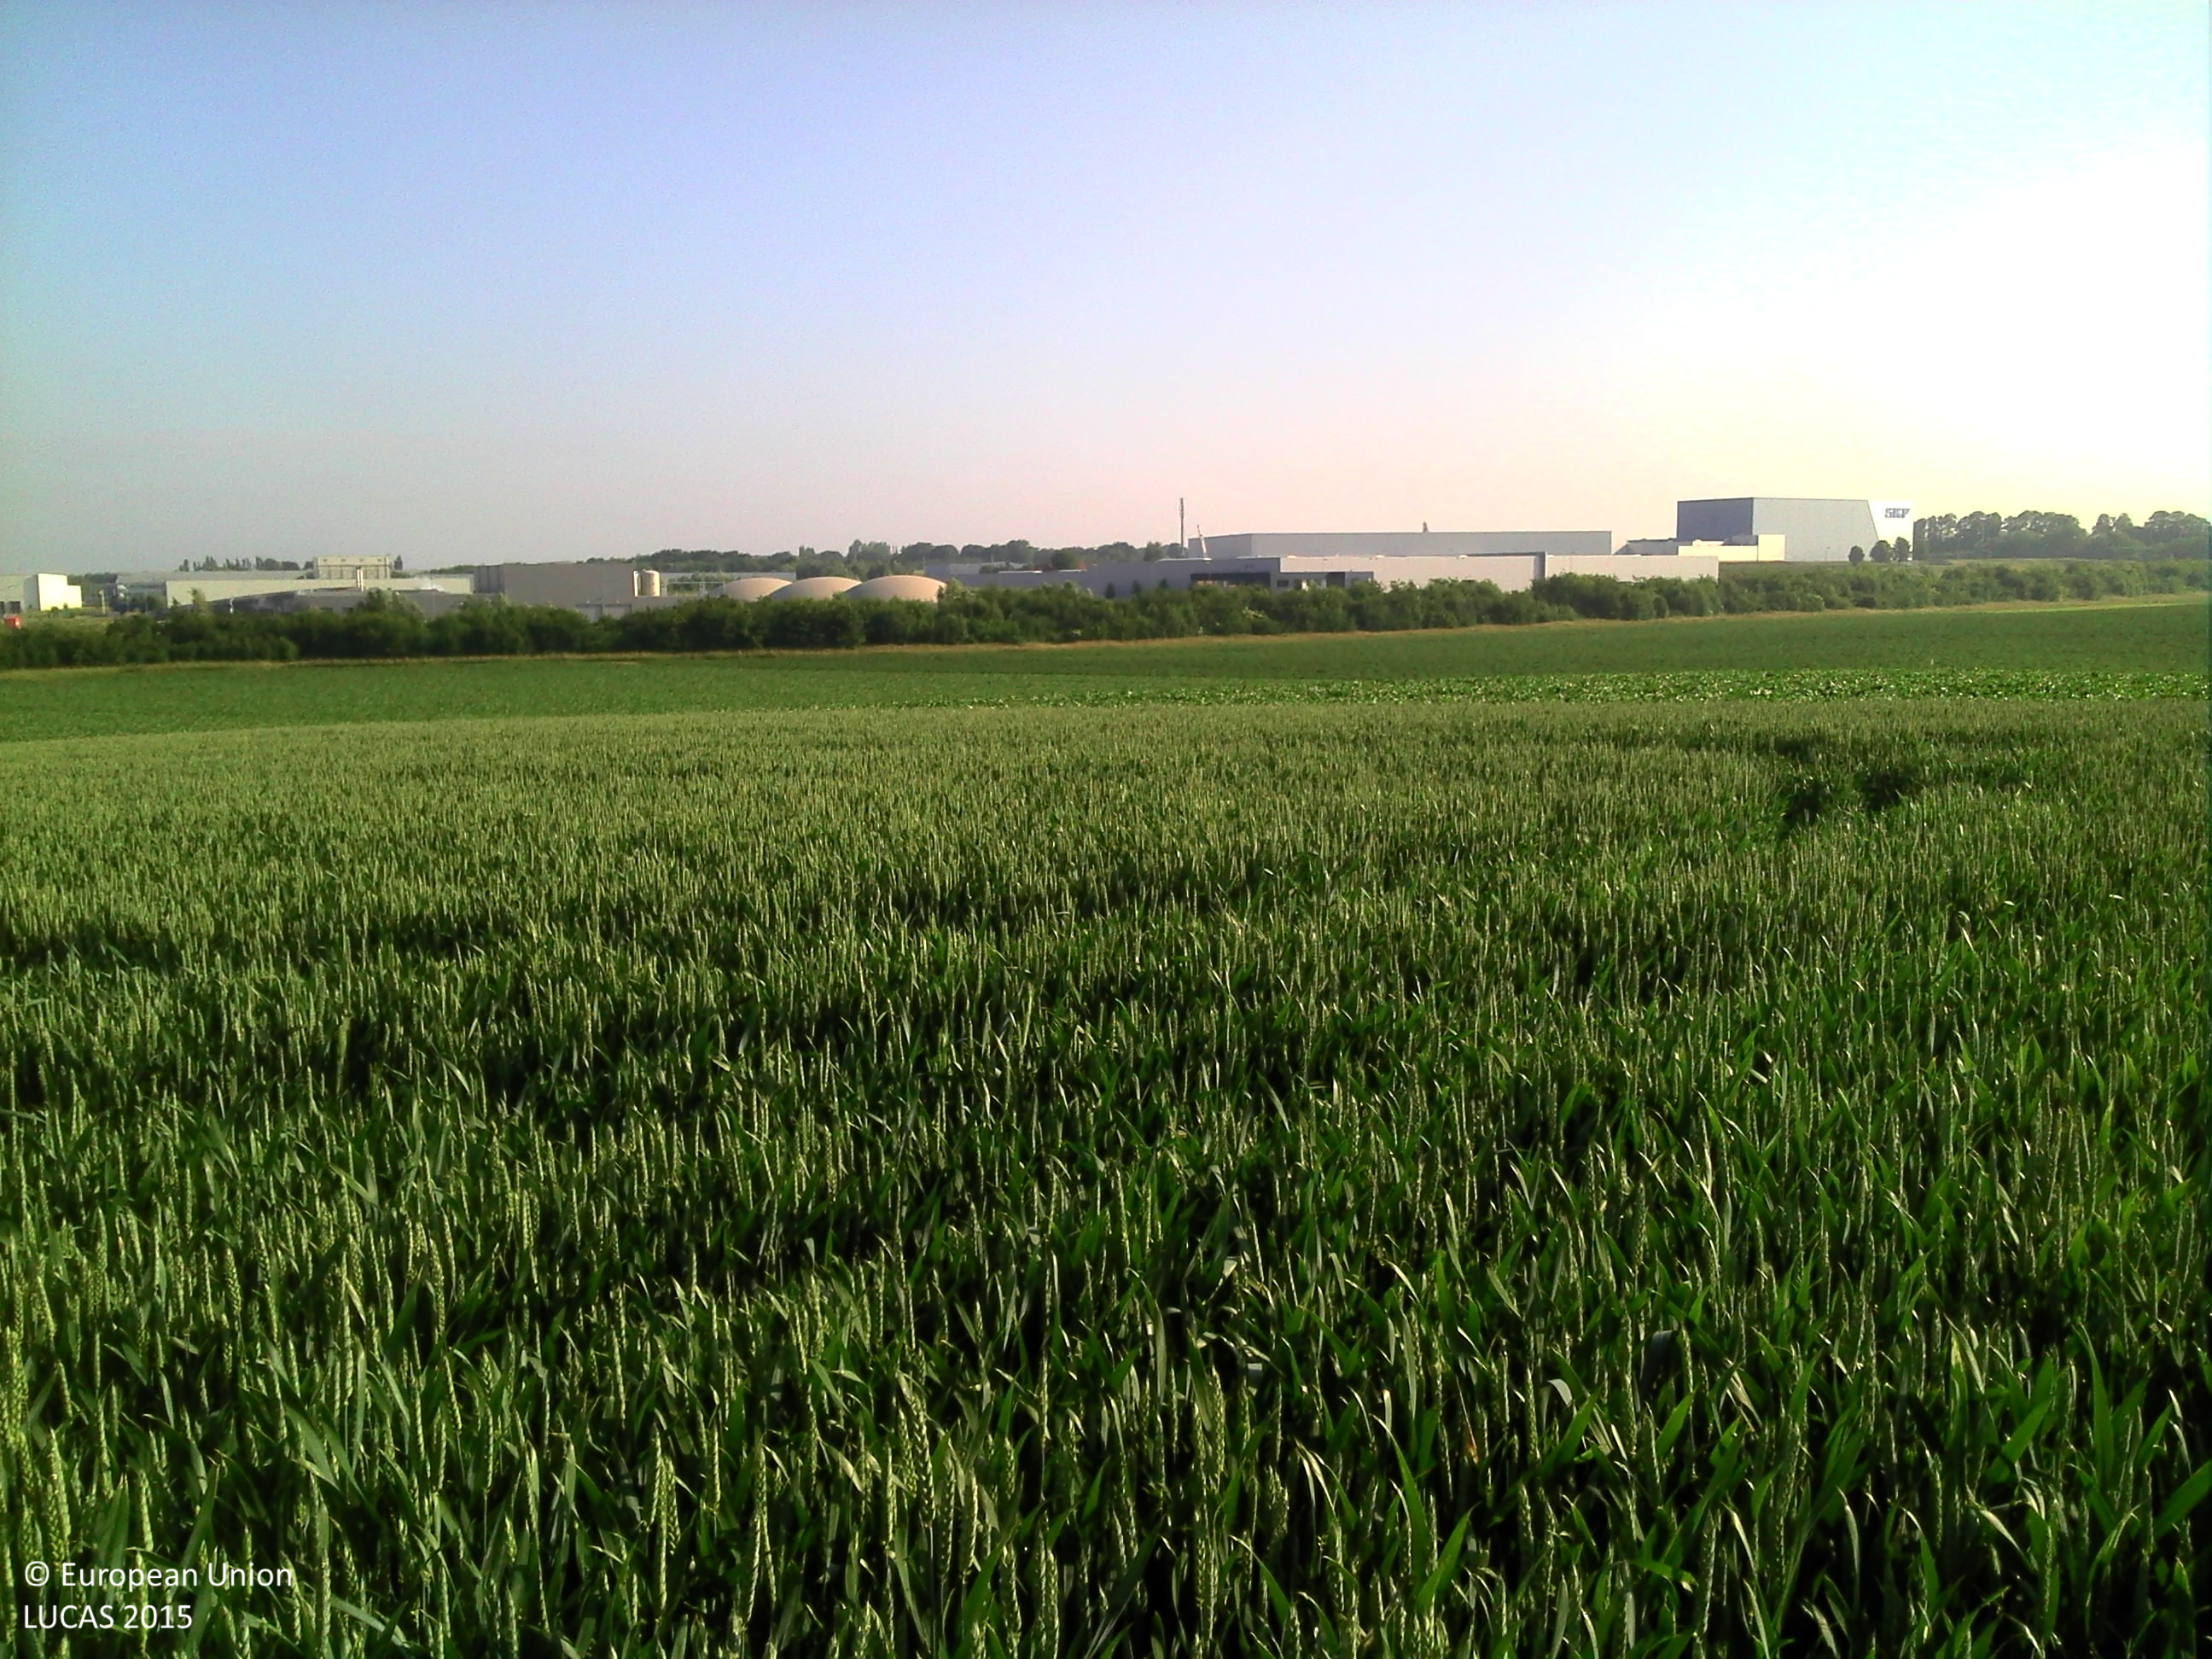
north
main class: Cropland
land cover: Common wheat
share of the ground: > 75 %
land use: Agriculture (excluding fallow land and kitchen gardens)
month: June
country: BE
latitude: 50.7810
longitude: 5.5306
